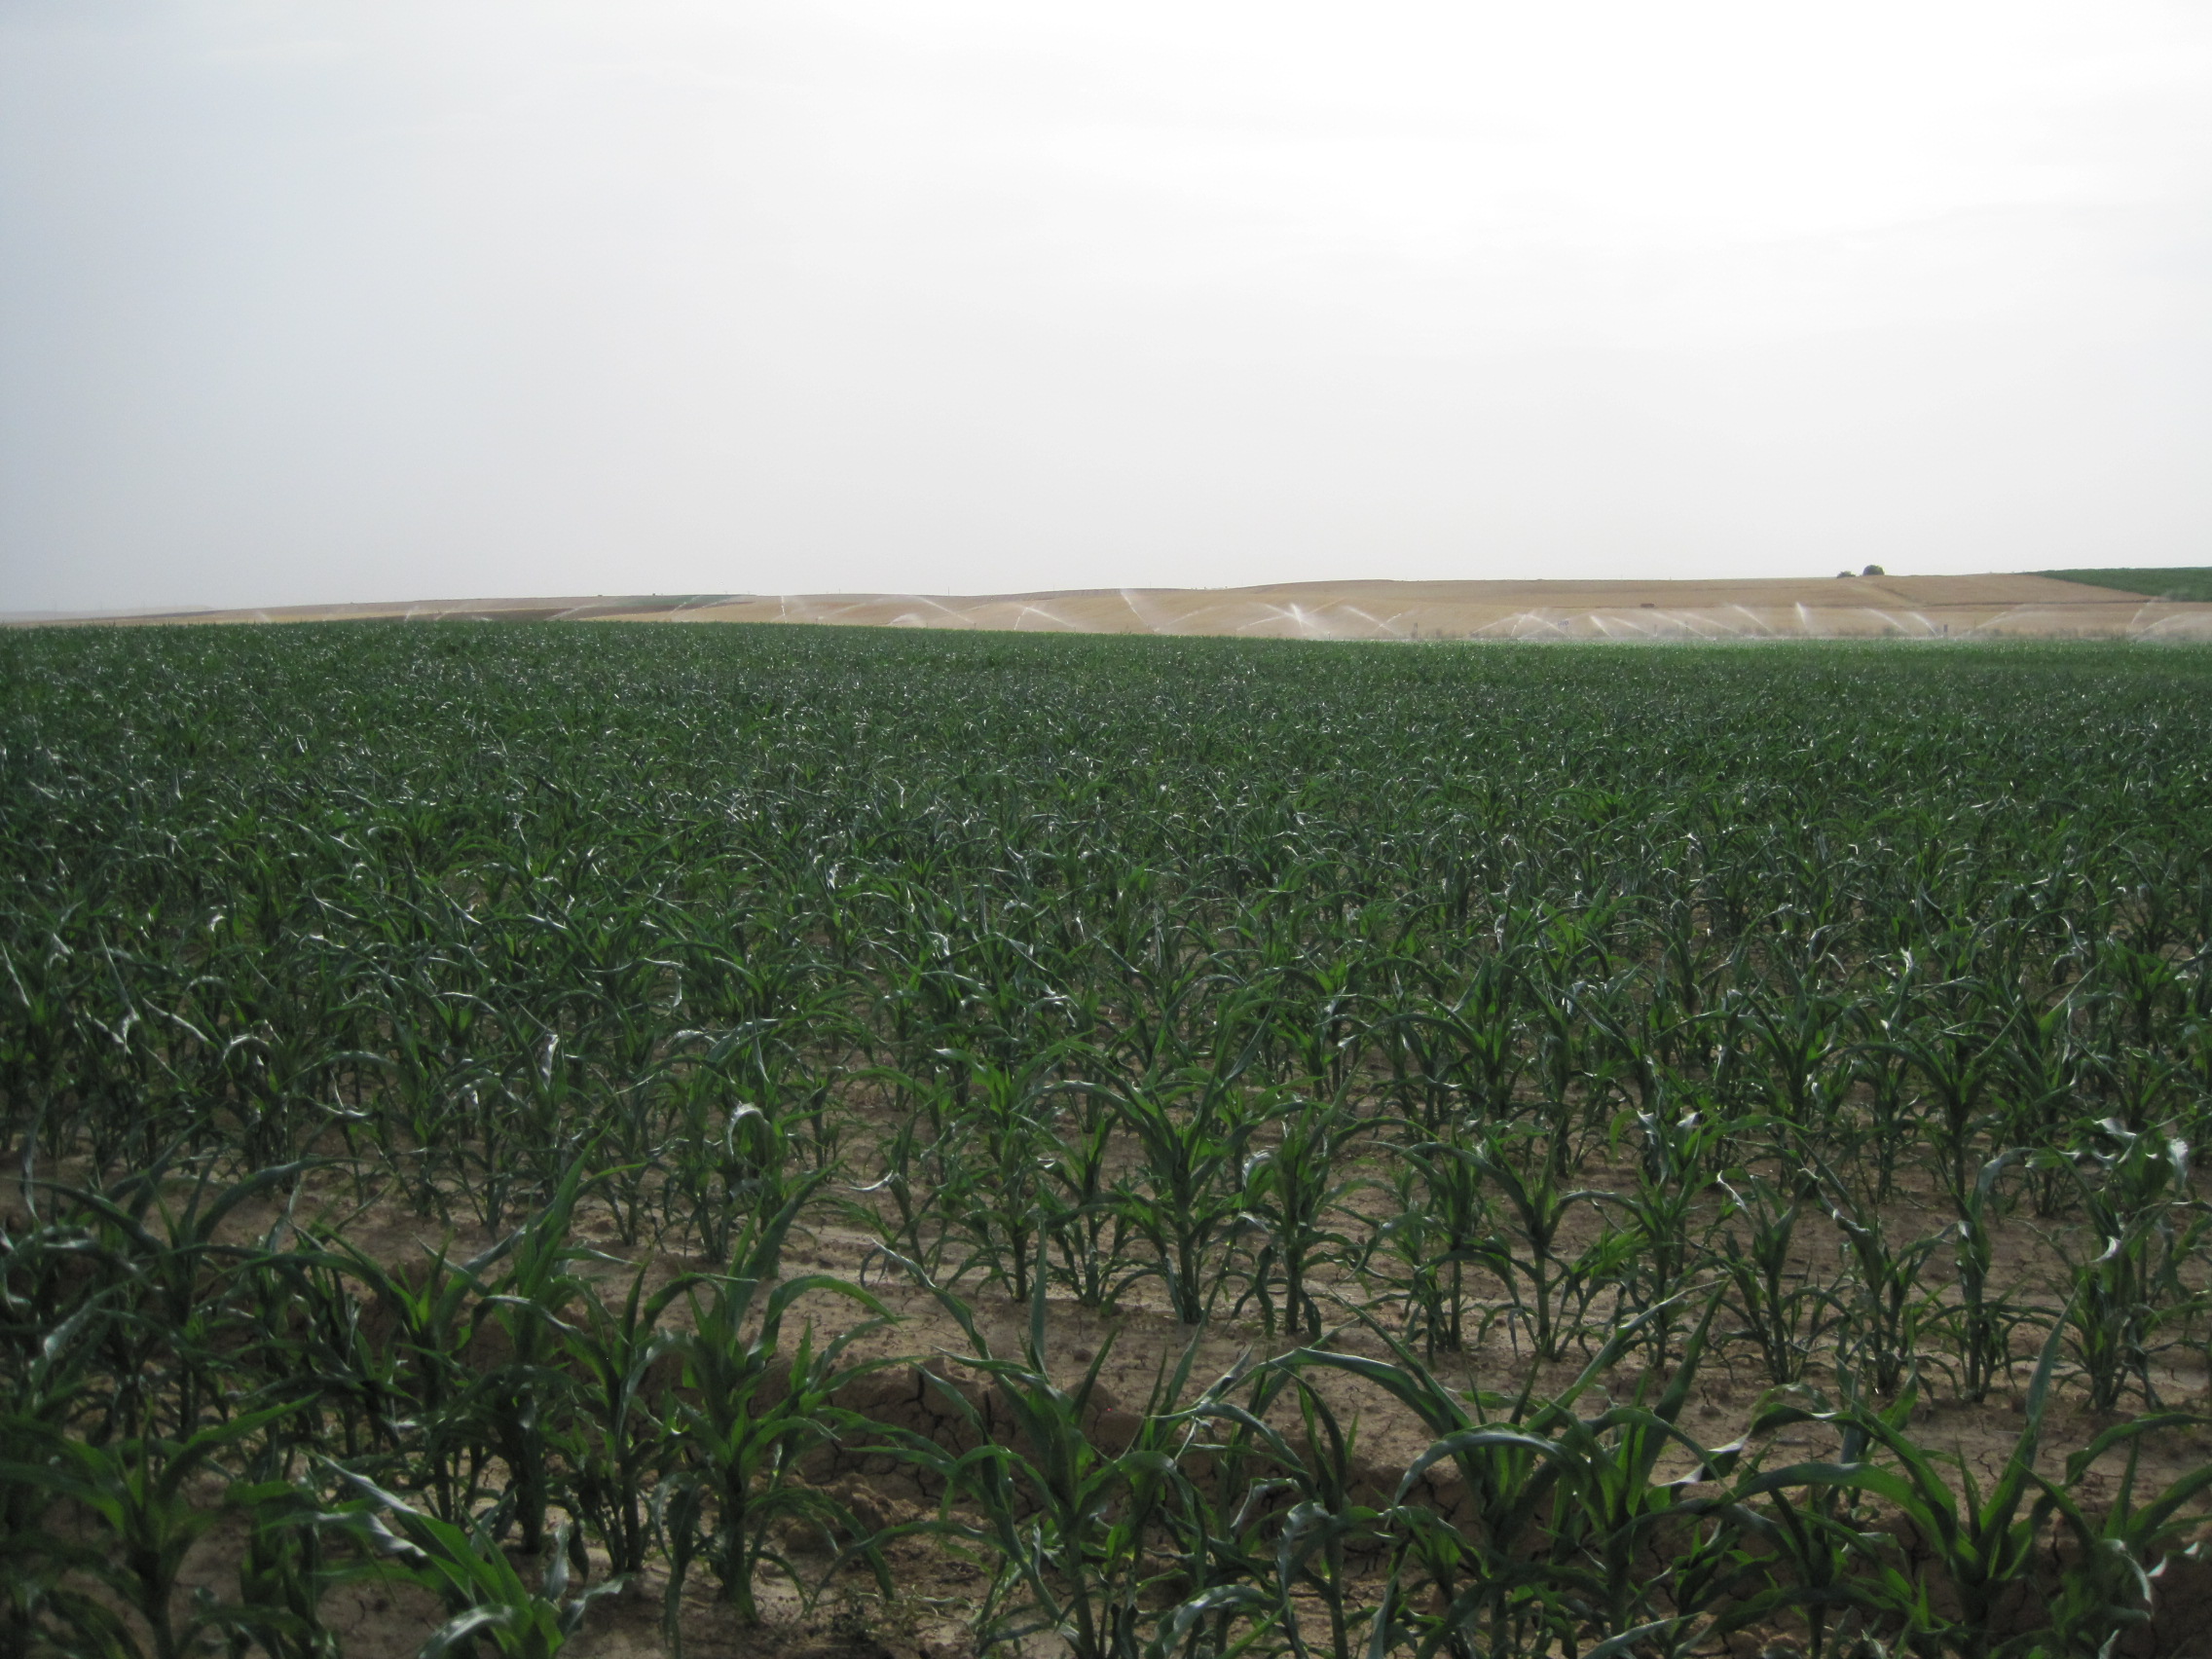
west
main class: Cropland
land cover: Maize
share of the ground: > 75 %
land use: Agriculture (excluding fallow land and kitchen gardens)
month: July
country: ES
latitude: 41.6780
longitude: -5.3487
